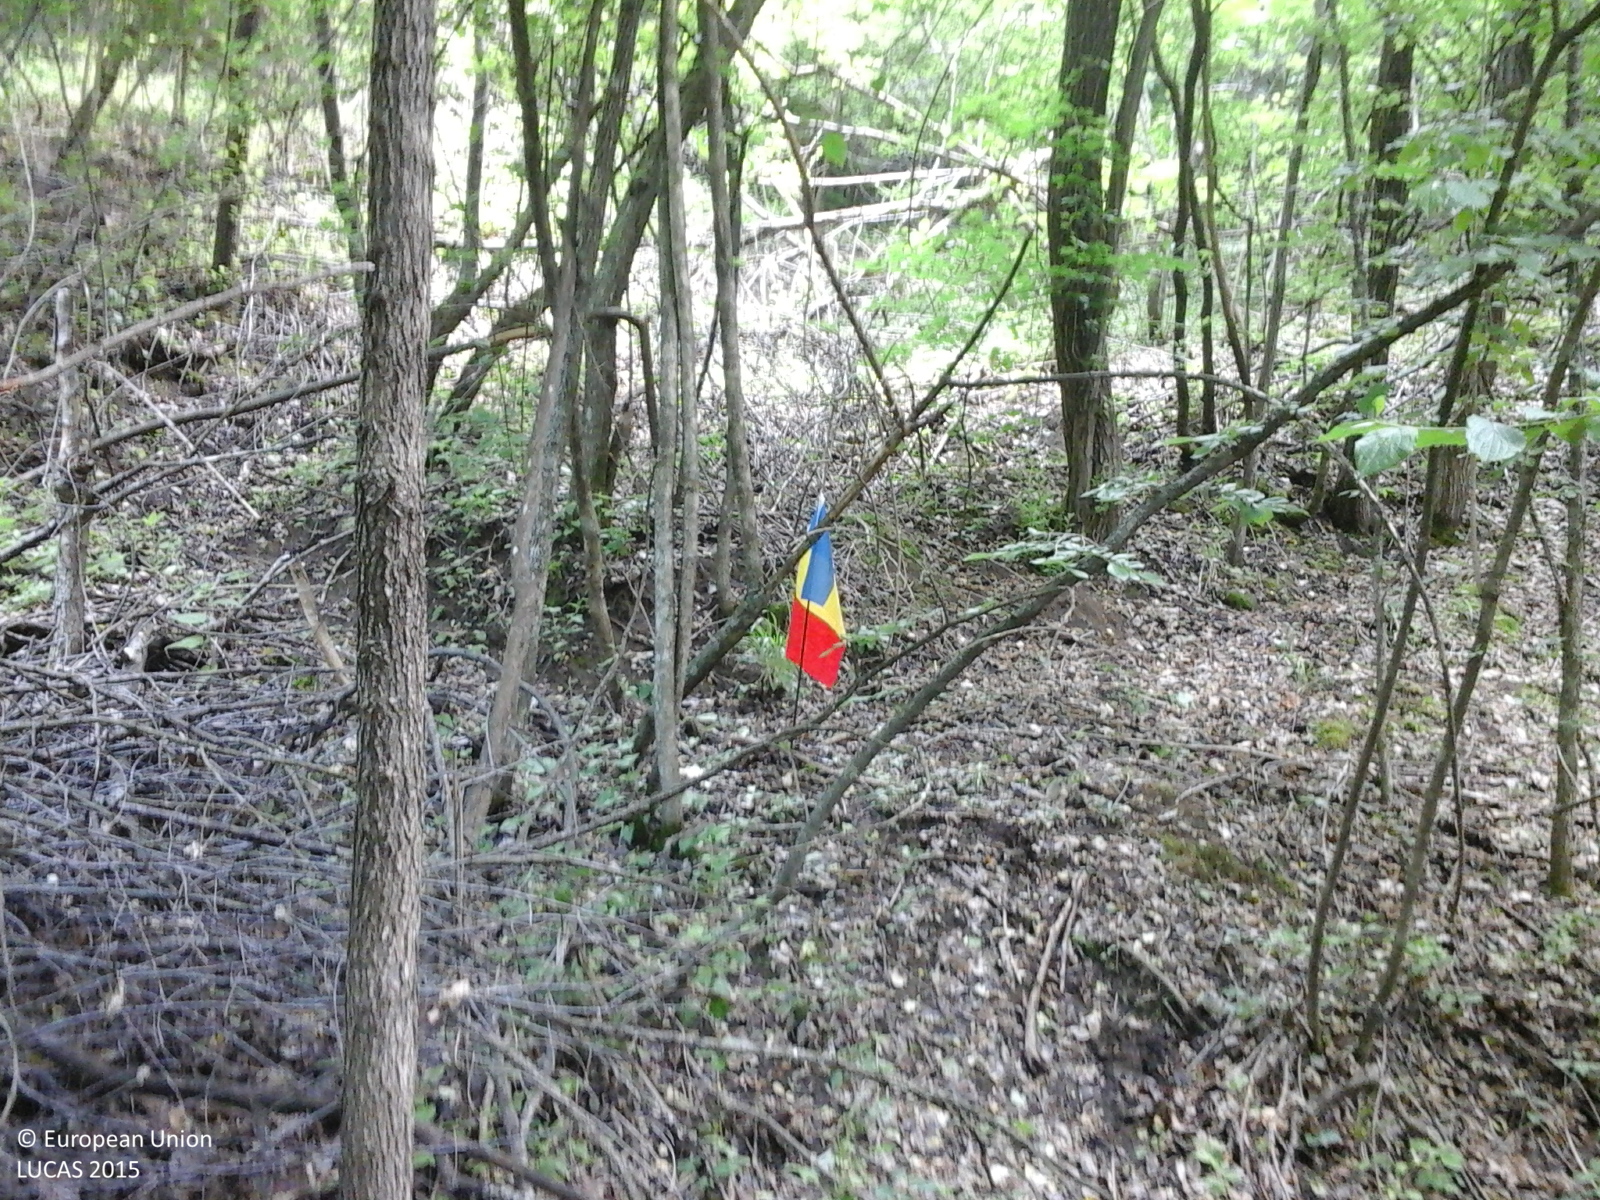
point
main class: Woodland
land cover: Broadleaved woodland
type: non-riverine alder, birch or aspen forest
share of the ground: > 75 %
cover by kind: broadleaved forest trees 100 %
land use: Forestry
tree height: > 5 m
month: May
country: RO
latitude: 45.2318
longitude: 26.0981
